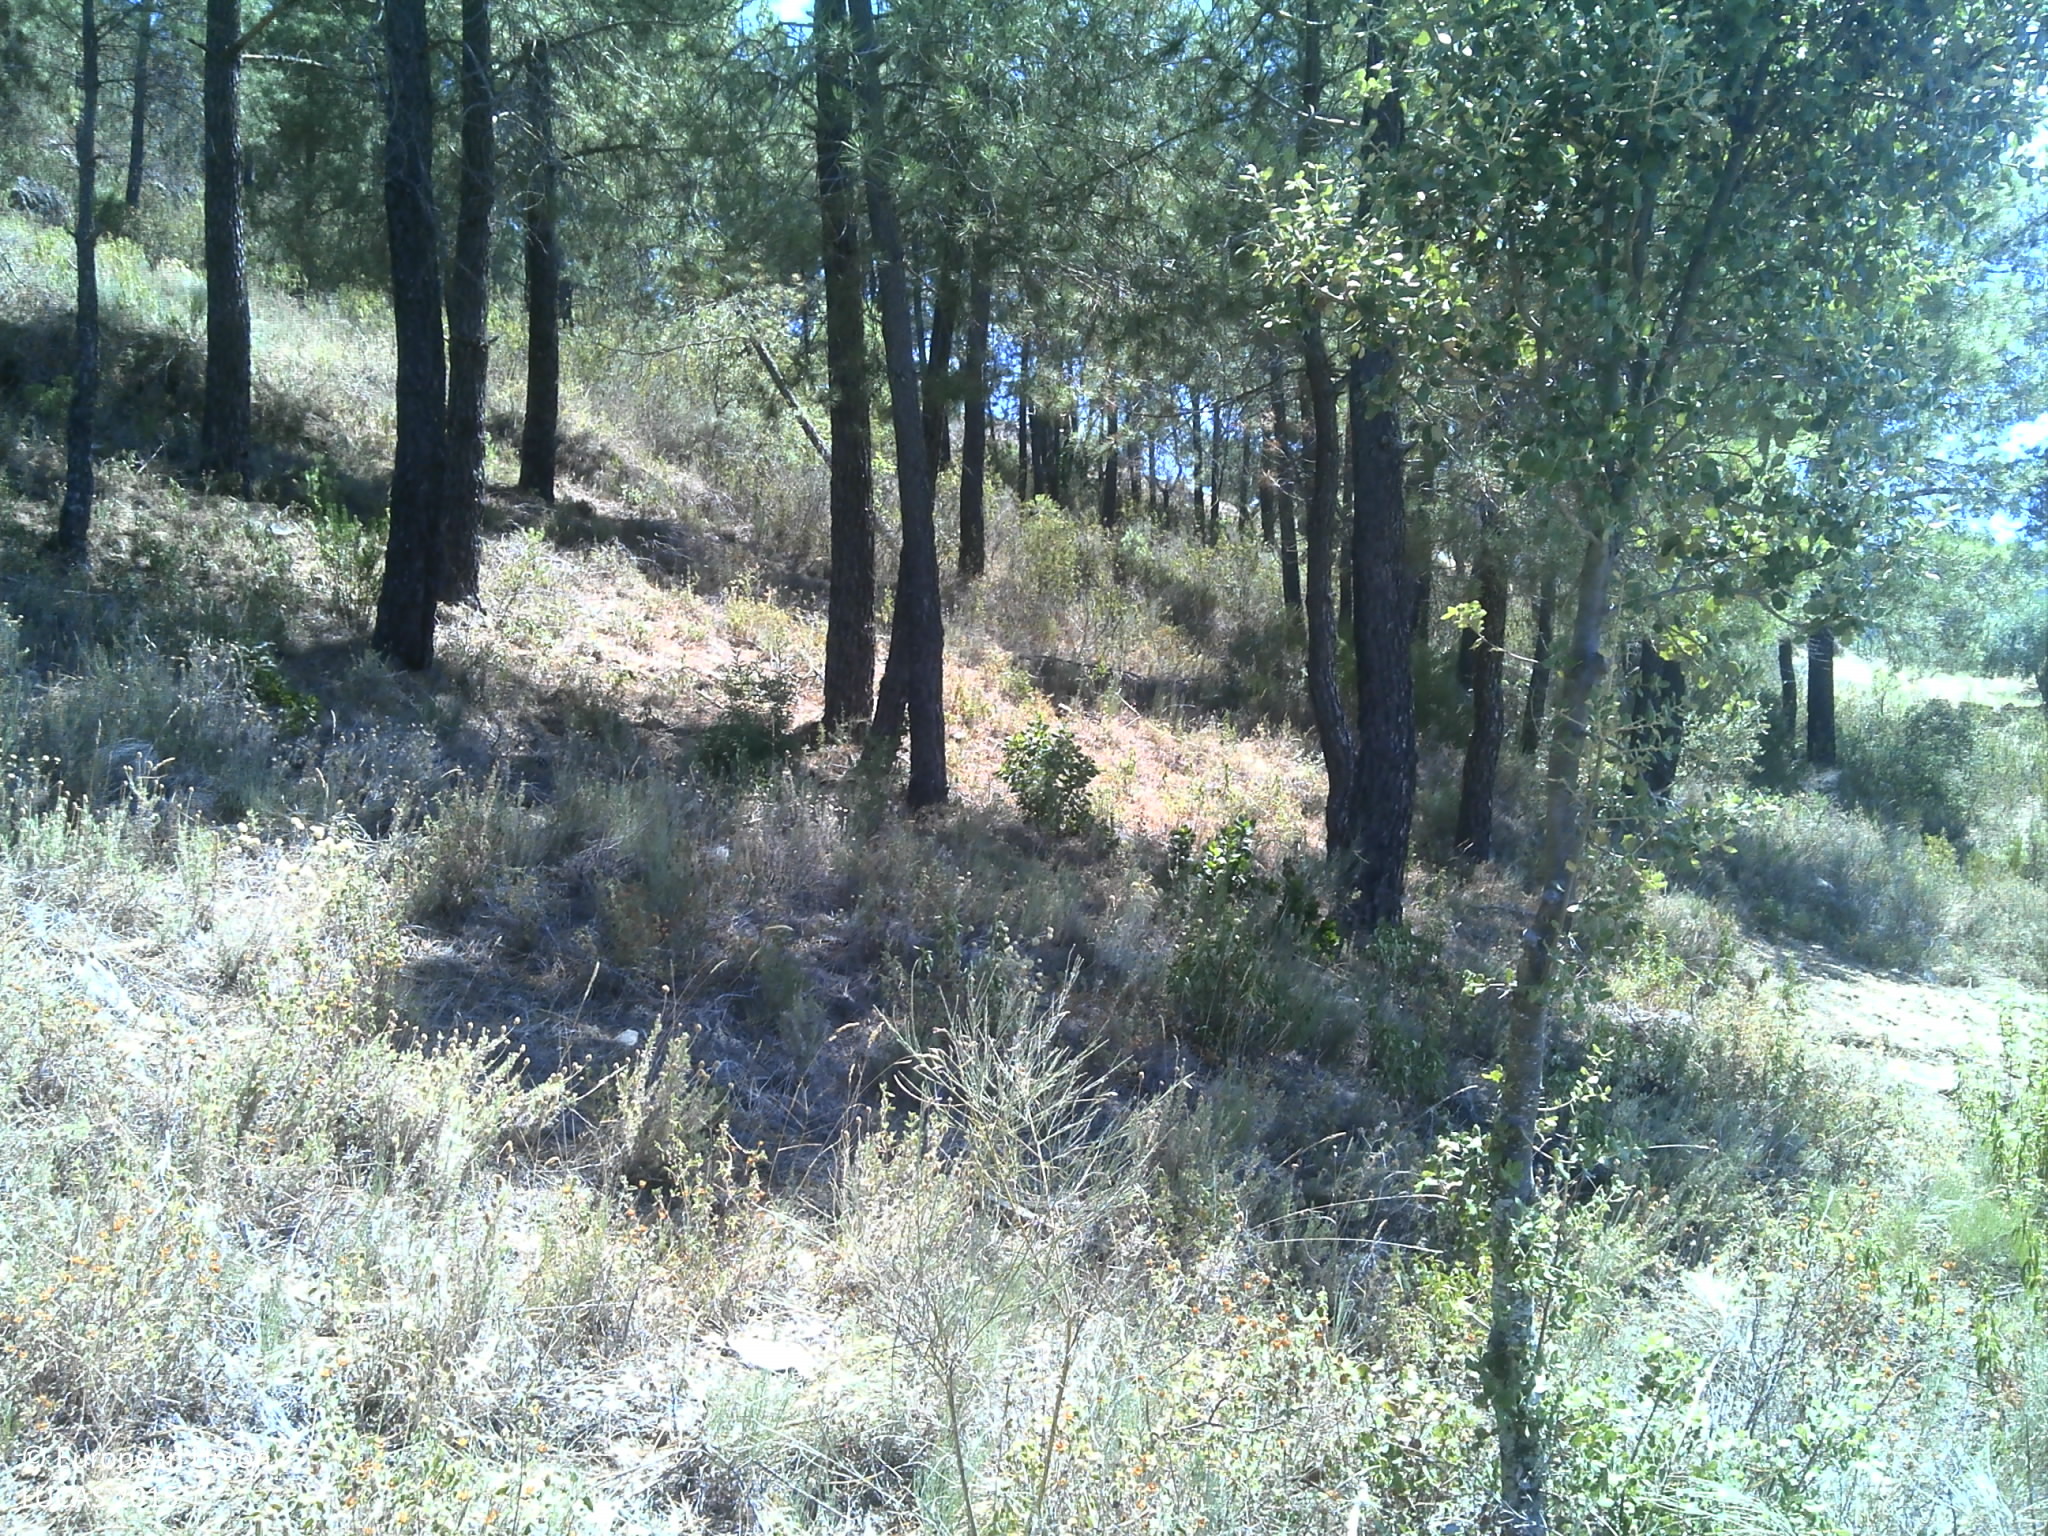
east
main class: Woodland
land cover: Pine dominated coniferous woodland
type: coniferous forest of the mediterranean region
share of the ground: 10 - 25 %
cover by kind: shrubs 35 %, unconsolidated bare surface 20 %, coniferous forest trees 15 %, herbaceous plants 10 %, consolidated bare surface 10 %
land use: Forestry
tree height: > 5 m
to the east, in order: Pine dominated coniferous woodland; Olive groves; Dry stone walls; Olive groves; Shruby margins; Ditches and canals; Shruby margins; Olive groves
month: July
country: PT
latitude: 41.3543
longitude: -7.1977
